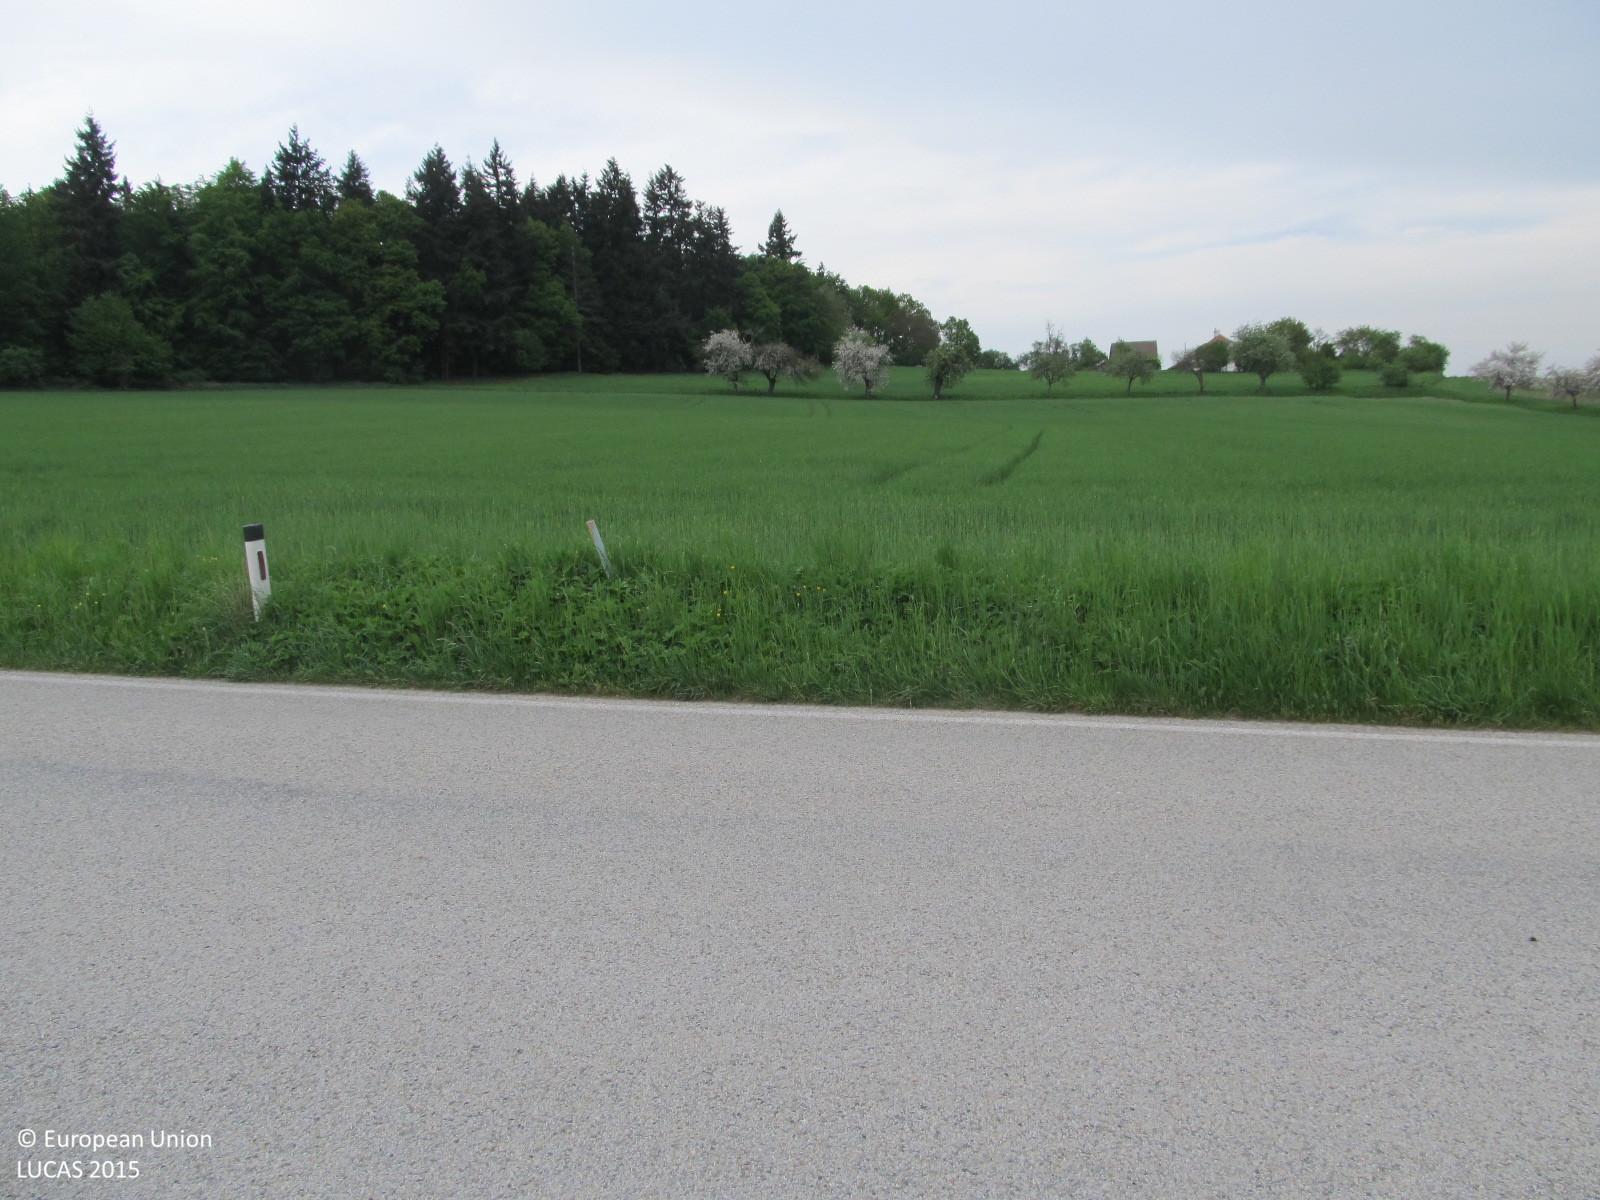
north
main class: Cropland
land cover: Common wheat
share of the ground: > 75 %
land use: Agriculture (excluding fallow land and kitchen gardens)
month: May
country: AT
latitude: 48.5323
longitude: 15.5960
